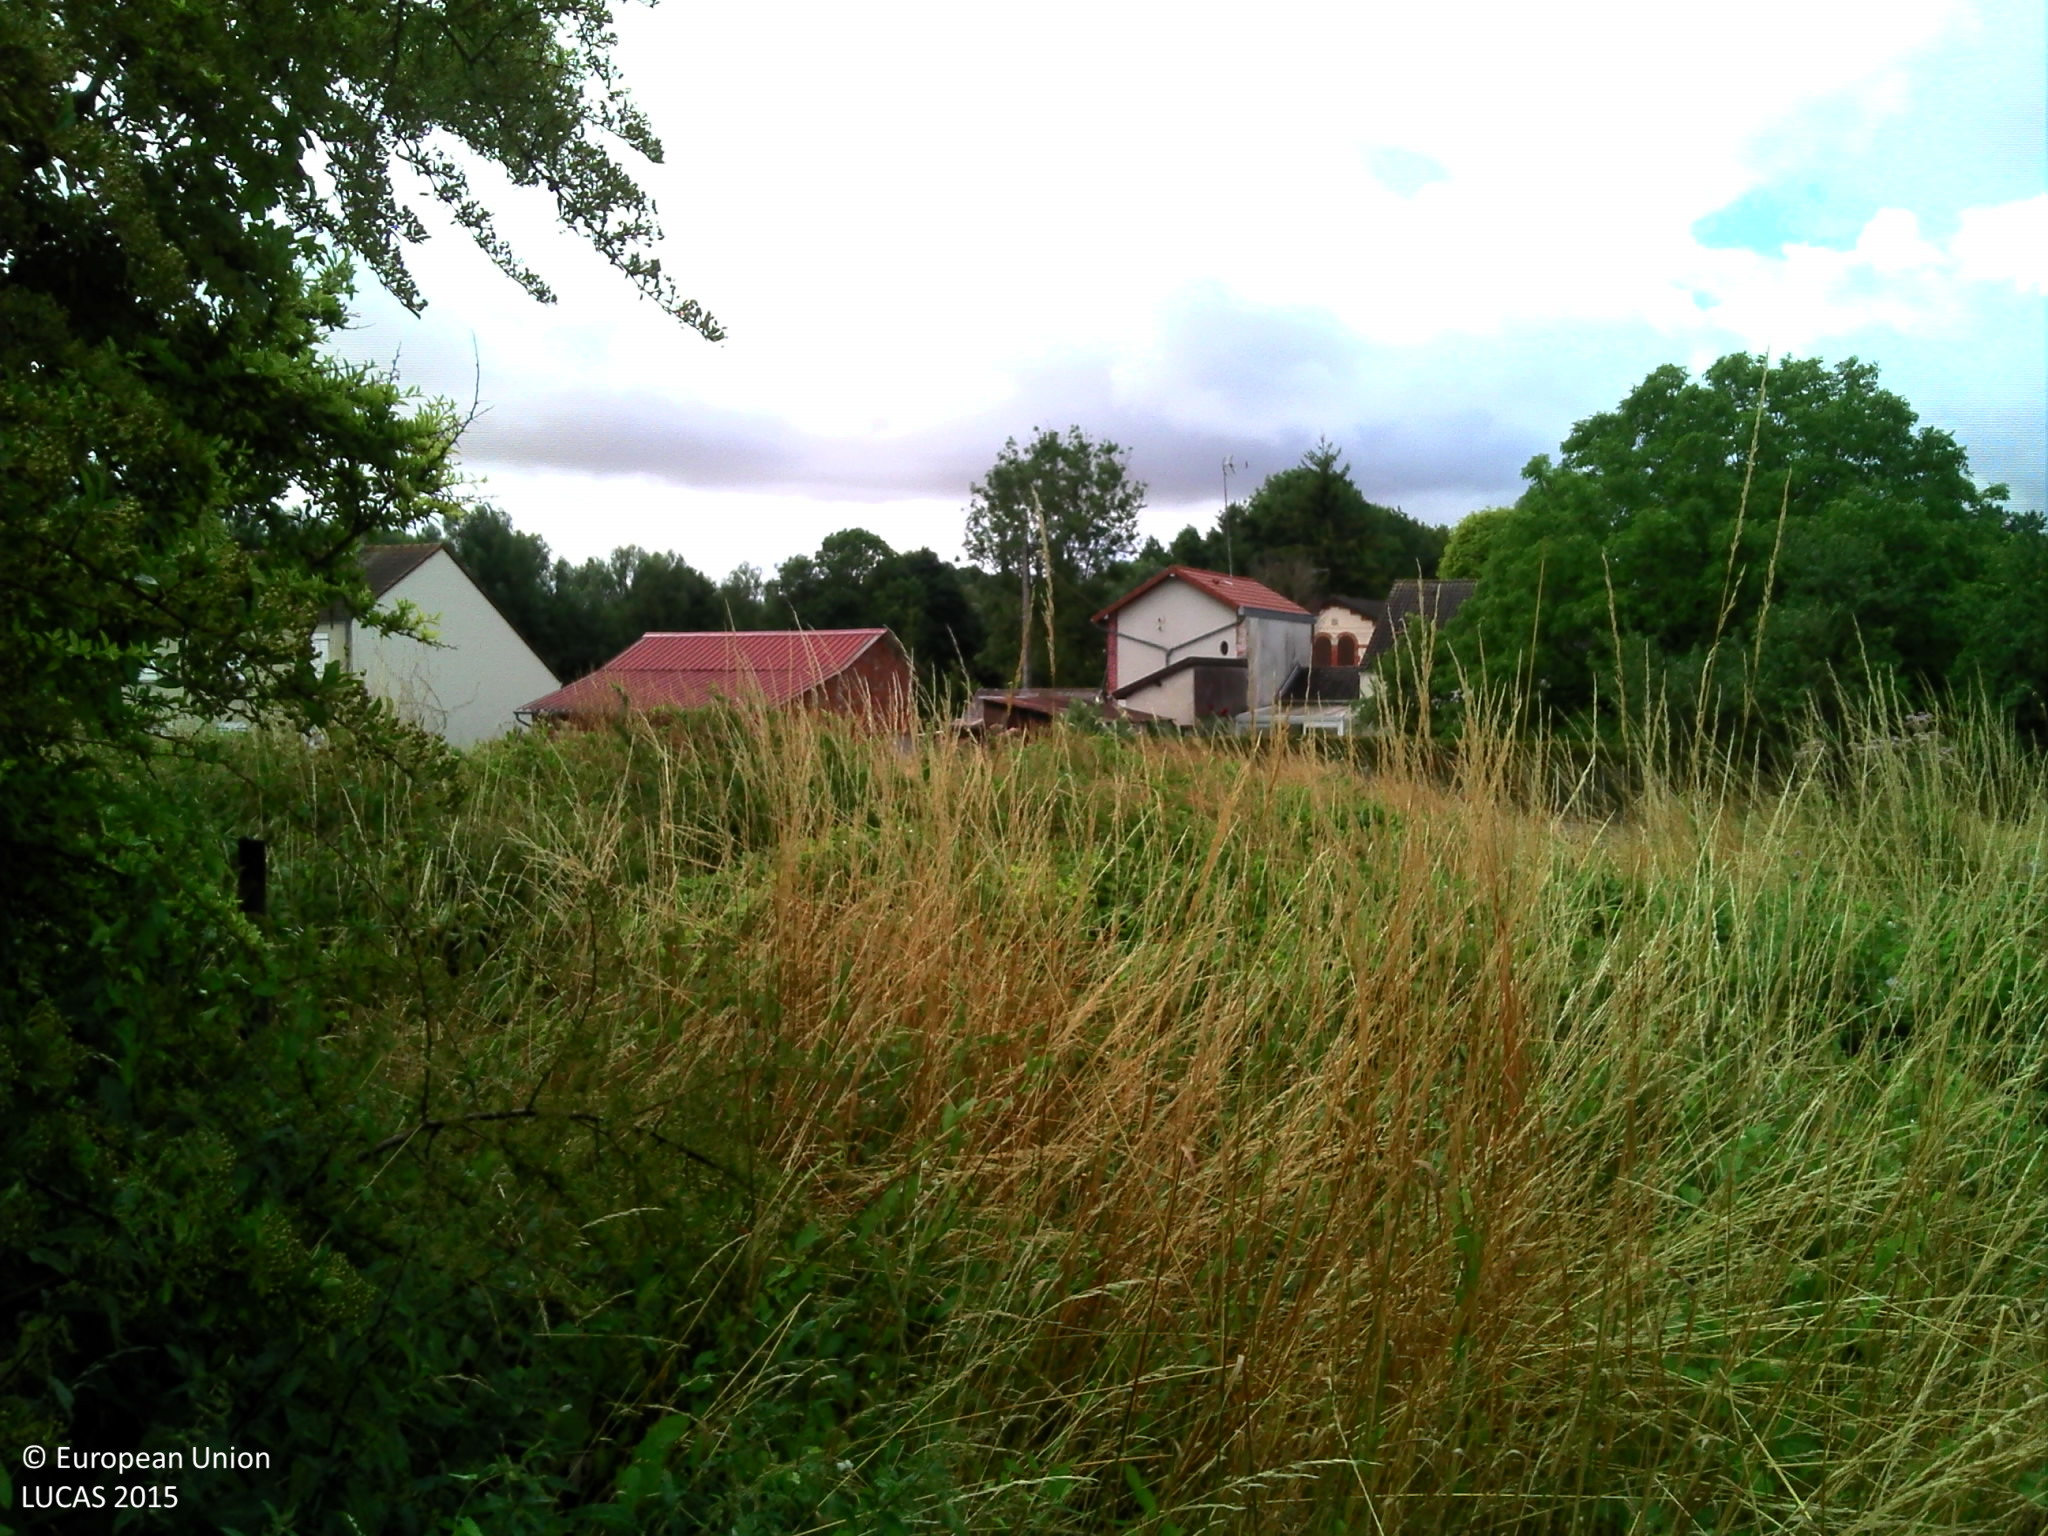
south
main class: Woodland
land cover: Broadleaved woodland
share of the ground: > 75 %
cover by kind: herbaceous plants 45 %, broadleaved forest trees 40 %, lichens and mosses 5 %, unconsolidated bare surface 5 %
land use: Semi-natural and natural areas not in use
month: July
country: FR
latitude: 49.1335
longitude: 4.5281
